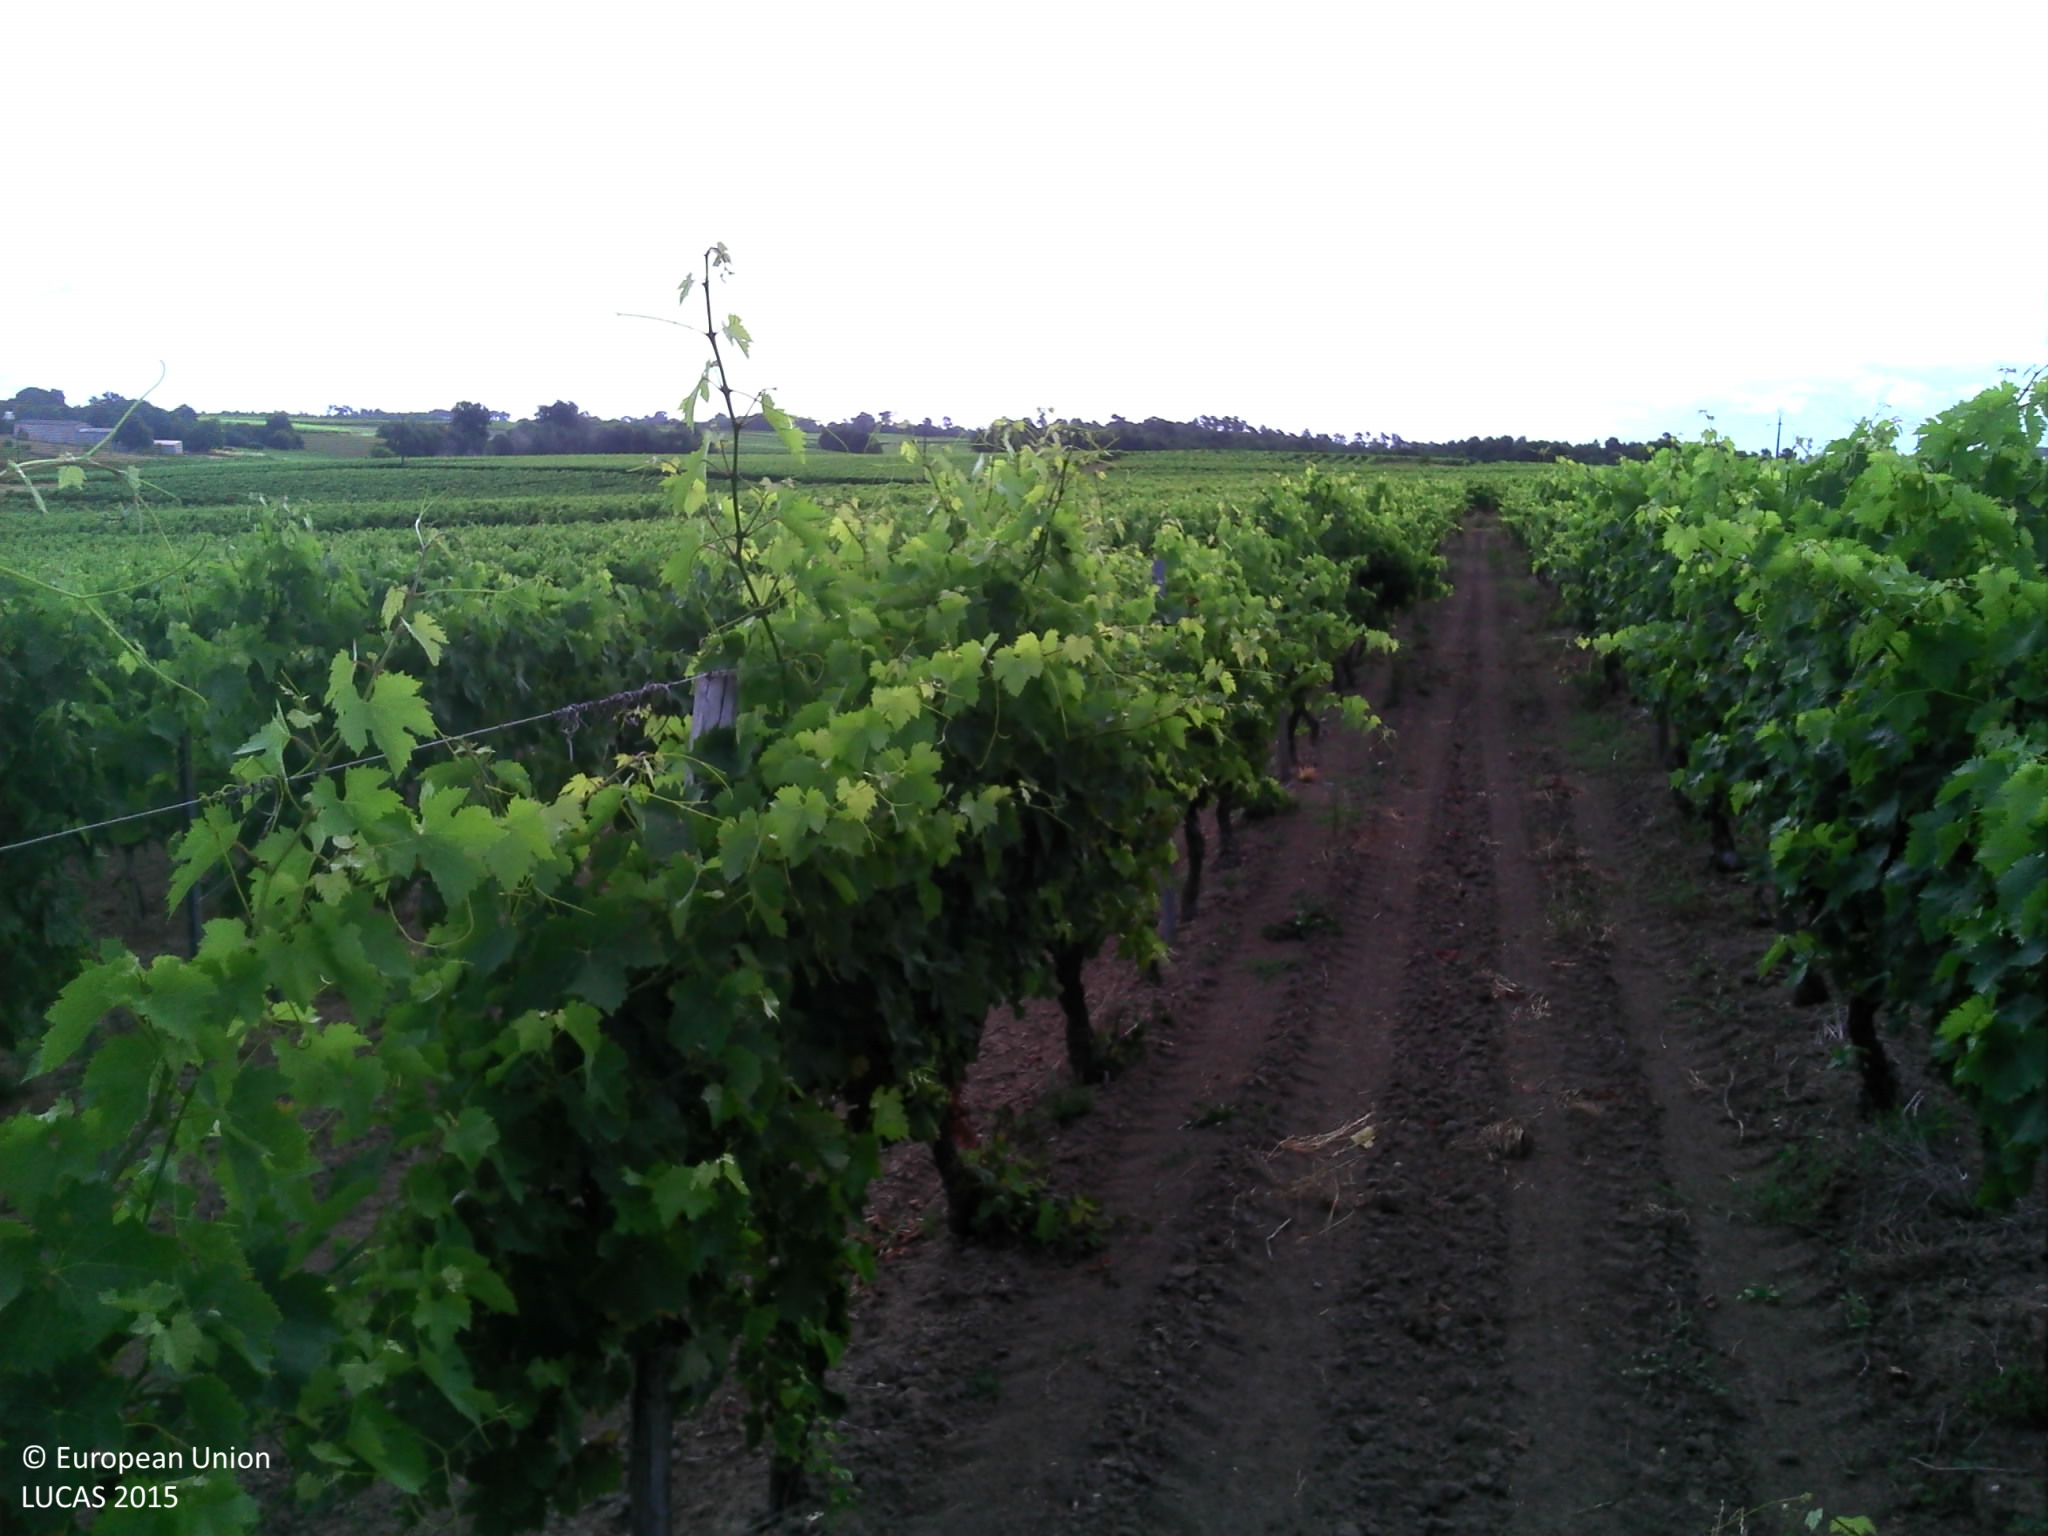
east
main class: Cropland
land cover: Vineyards
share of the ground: 50 - 75 %
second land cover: Other bare soil
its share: > 75 %
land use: Agriculture (excluding fallow land and kitchen gardens)
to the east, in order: Vineyards; Other bare soil; Grassland without tree/shrub cover; Grass margins; Paved roads, cycling and walking lanes; Grass margins; Vineyards
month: July
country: FR
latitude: 45.3301
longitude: -0.6248
